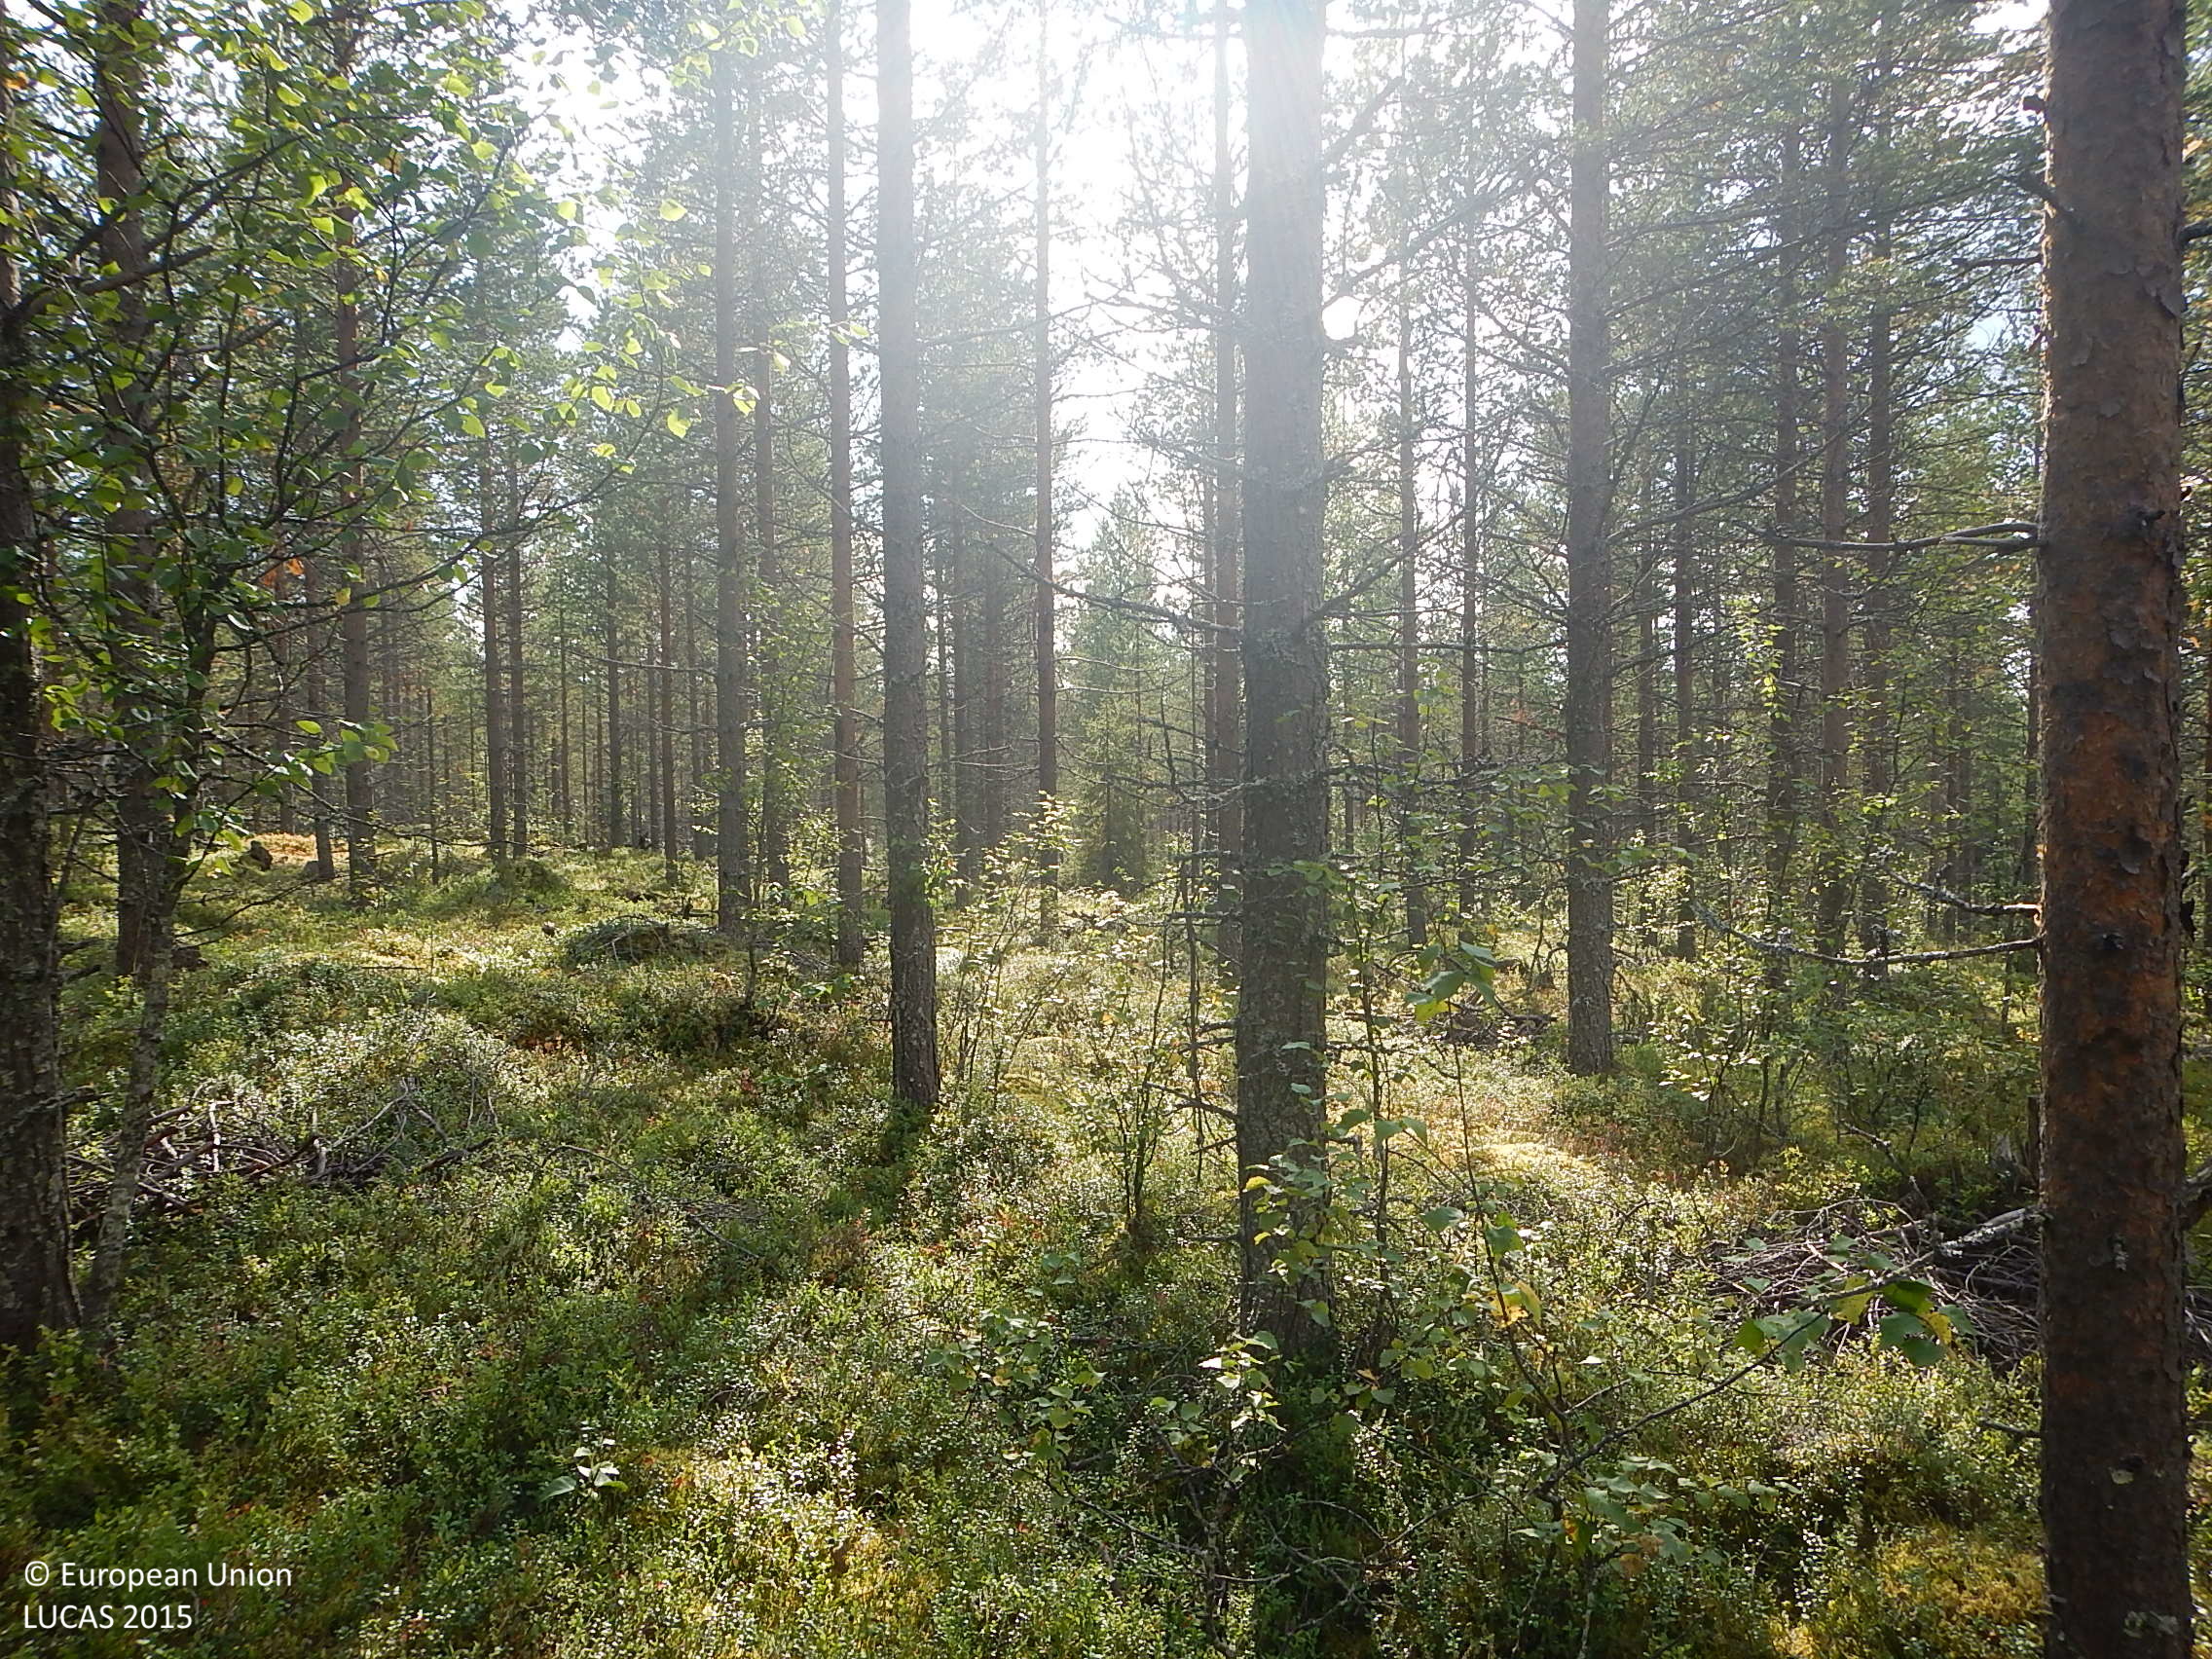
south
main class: Woodland
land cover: Pine dominated coniferous woodland
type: boreal forest
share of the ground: > 75 %
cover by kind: coniferous forest trees 75 %, shrubs 20 %, lichens and mosses 5 %
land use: Forestry
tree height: > 5 m
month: August
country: FI
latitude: 66.1199
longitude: 27.4522
